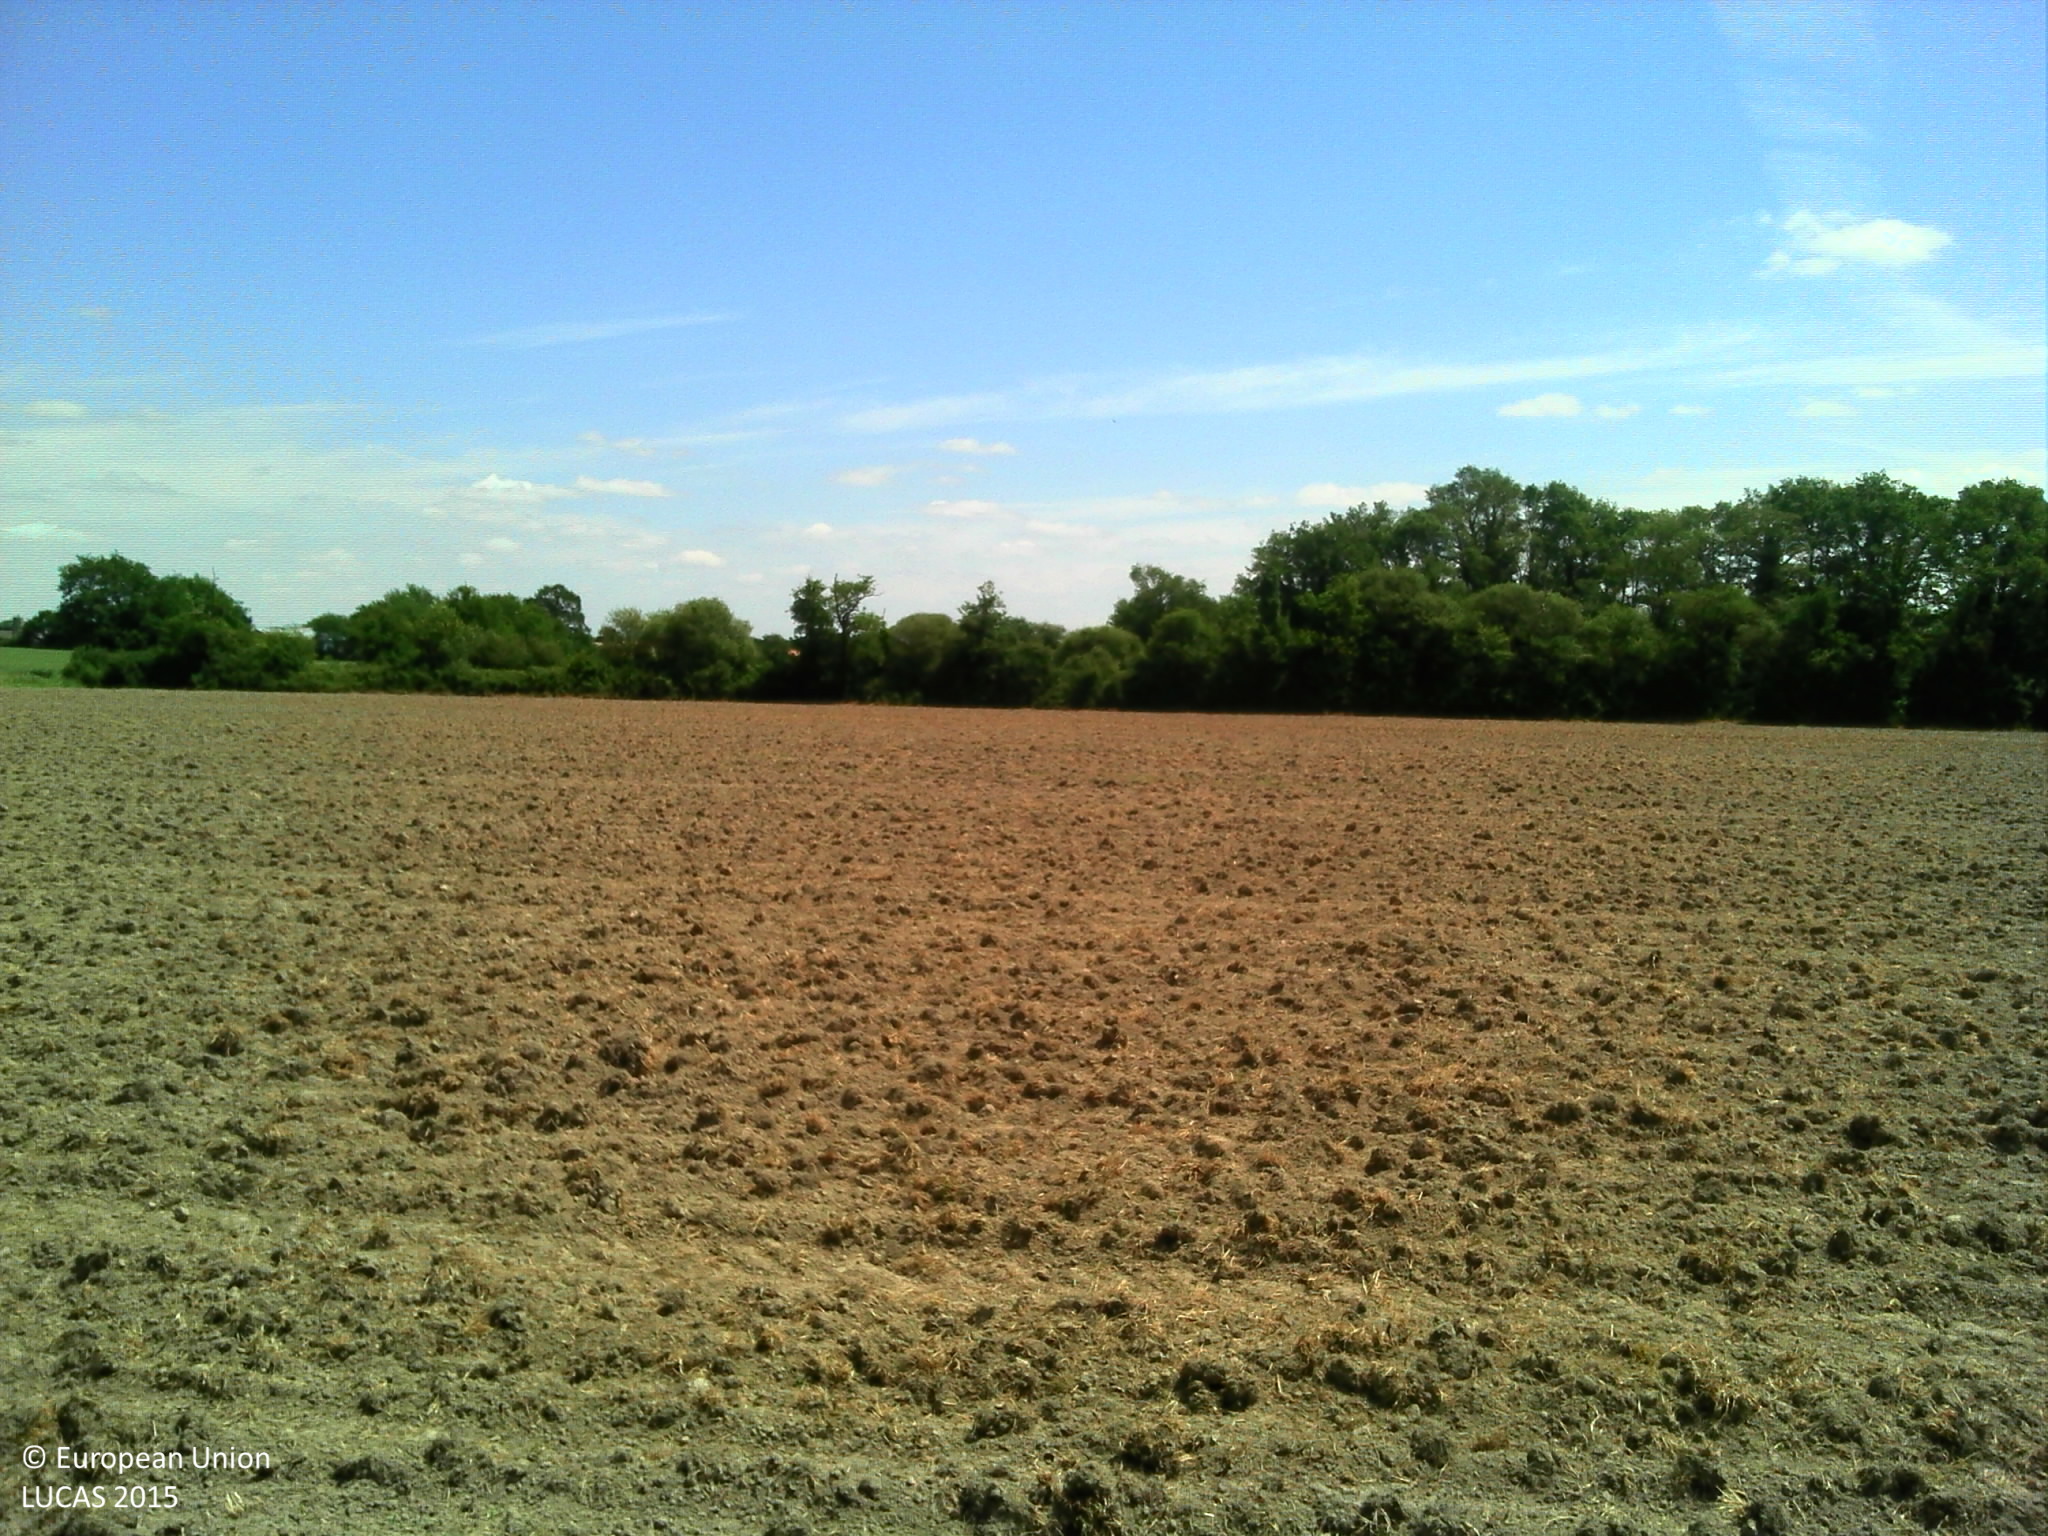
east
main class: Cropland
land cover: Maize
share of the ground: < 10 %
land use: Agriculture (excluding fallow land and kitchen gardens)
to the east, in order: Maize; Managed hedges; Ditches and canals; Fences; Grassland without tree/shrub cover; Fences; Ditches and canals; Managed hedges; Grass margins; Common wheat
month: May
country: FR
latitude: 47.0117
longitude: -1.2312
